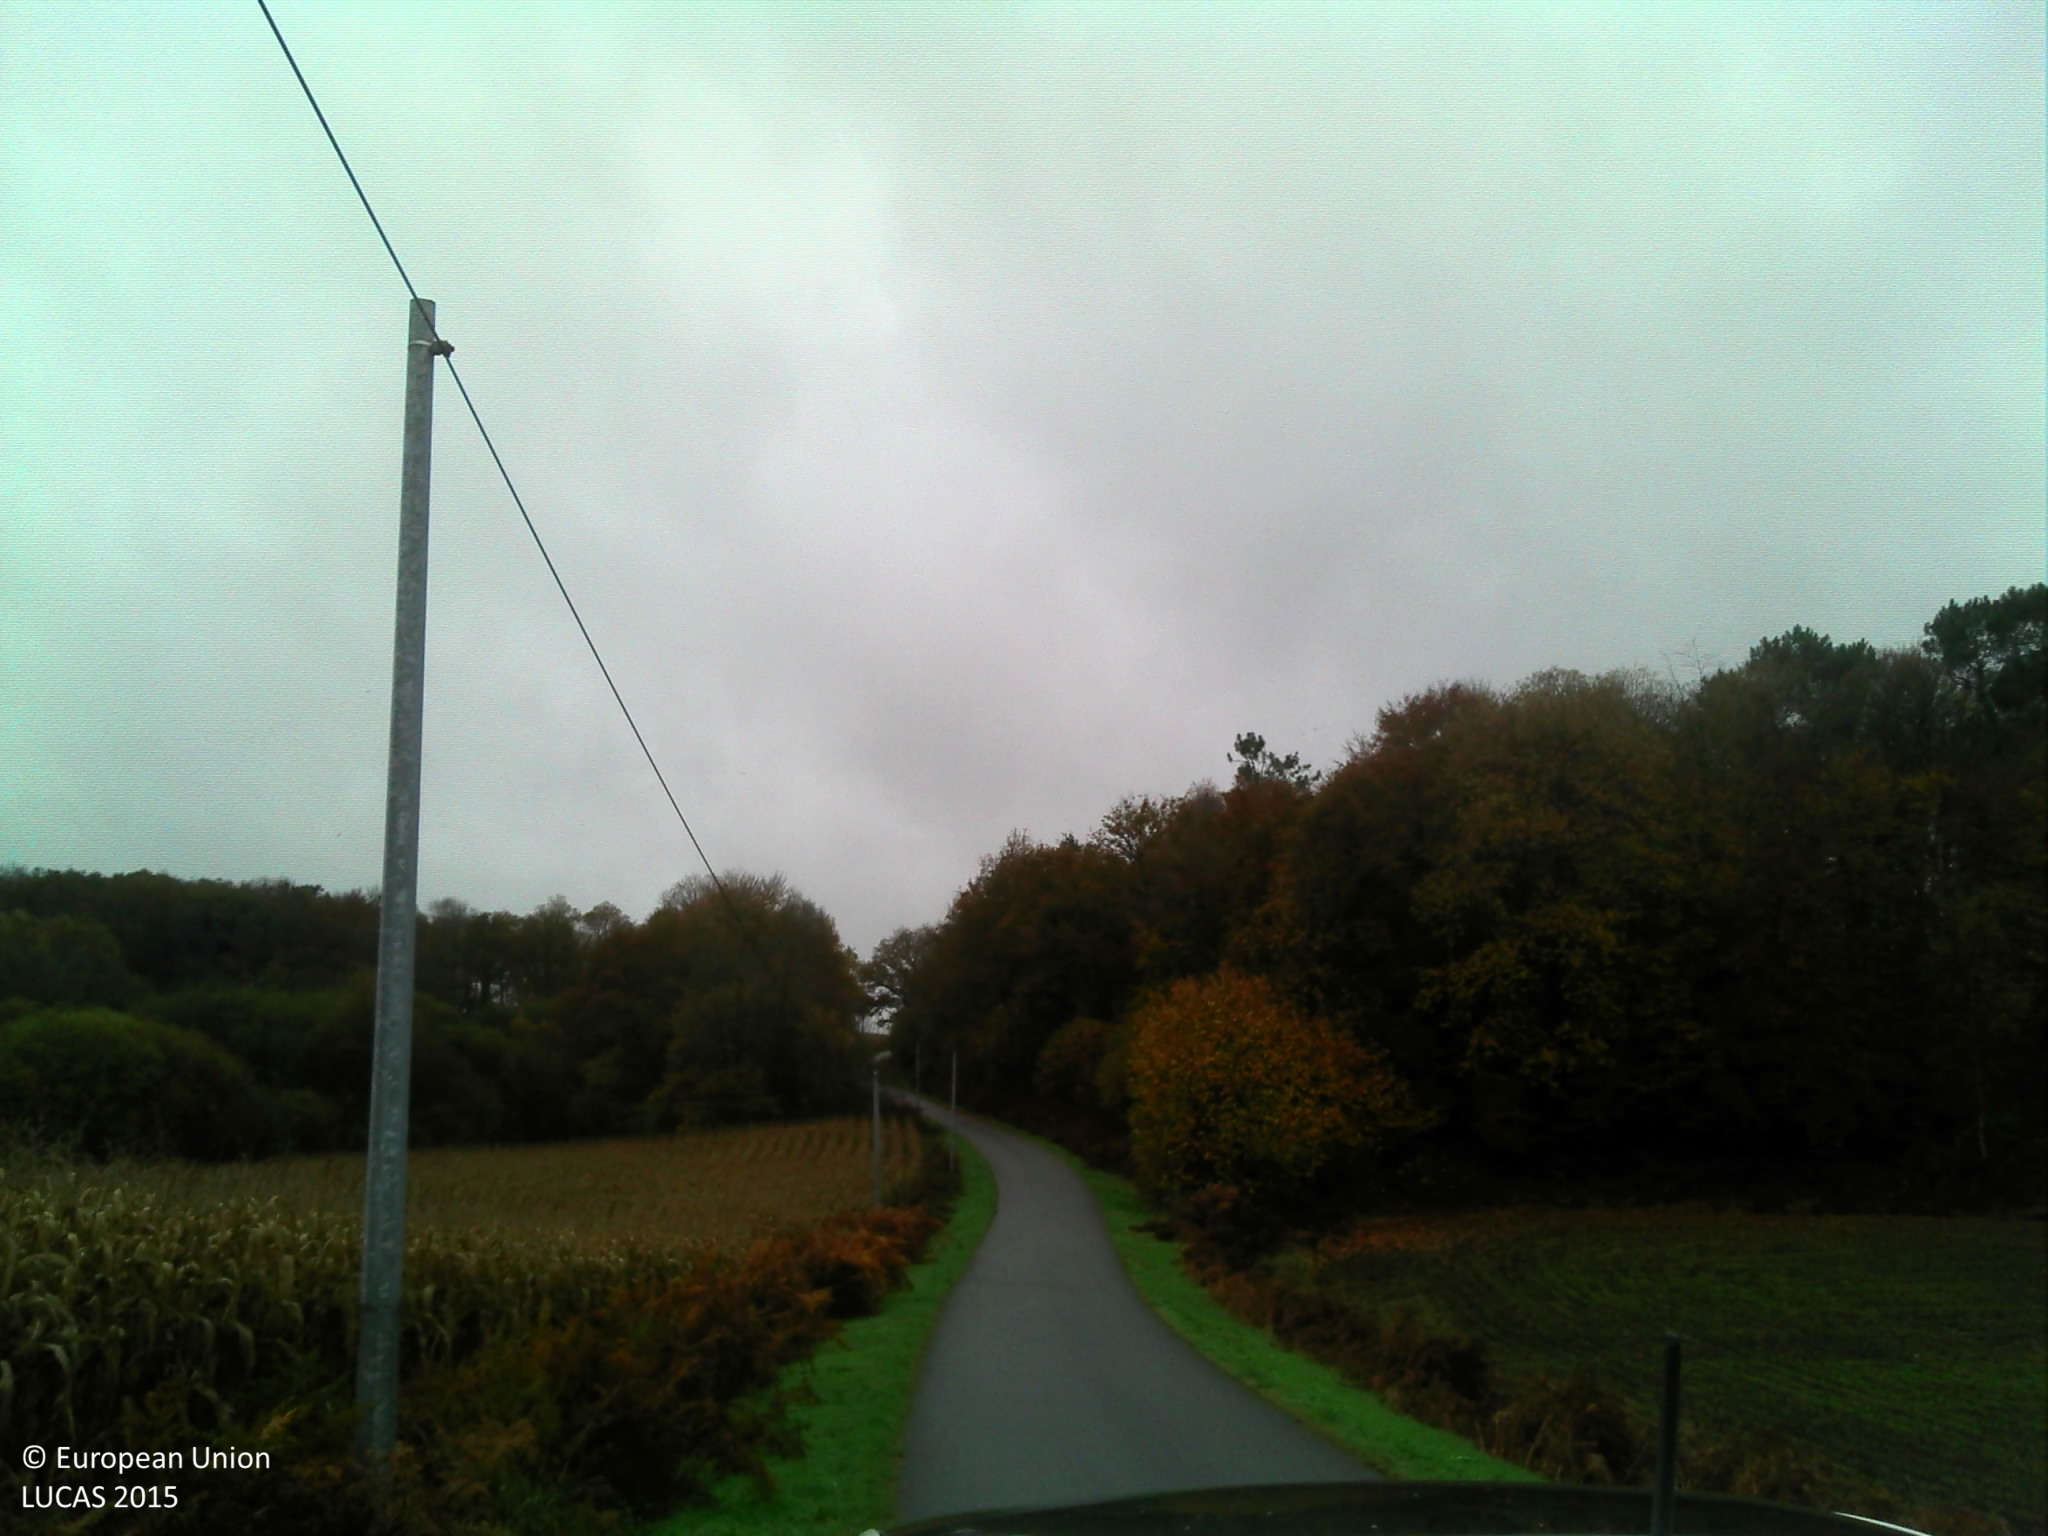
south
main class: Cropland
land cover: Maize
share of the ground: > 75 %
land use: Agriculture (excluding fallow land and kitchen gardens)
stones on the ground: < 10 %
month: November
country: FR
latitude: 47.9437
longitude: -3.2865
